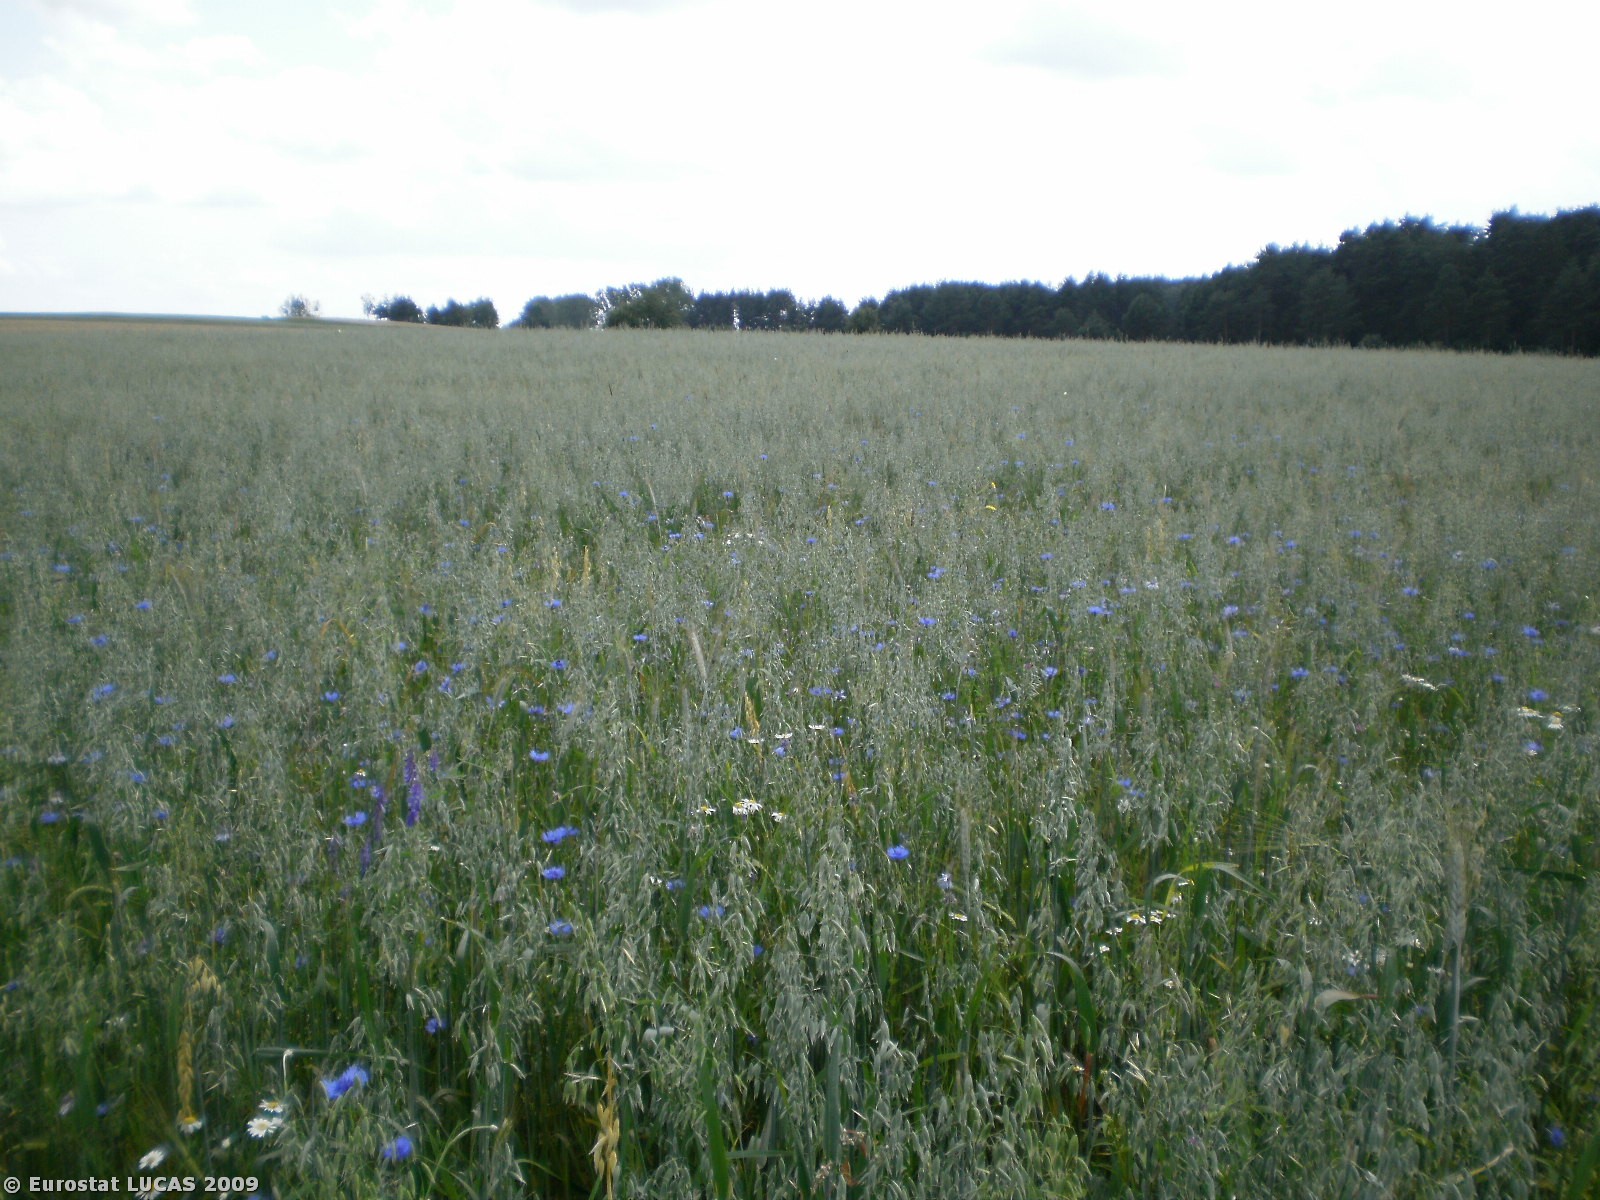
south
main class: Cropland
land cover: Oats
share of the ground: > 75 %
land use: Agriculture (excluding fallow land and kitchen gardens)
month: July
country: PL
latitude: 53.2641
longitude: 20.3656
